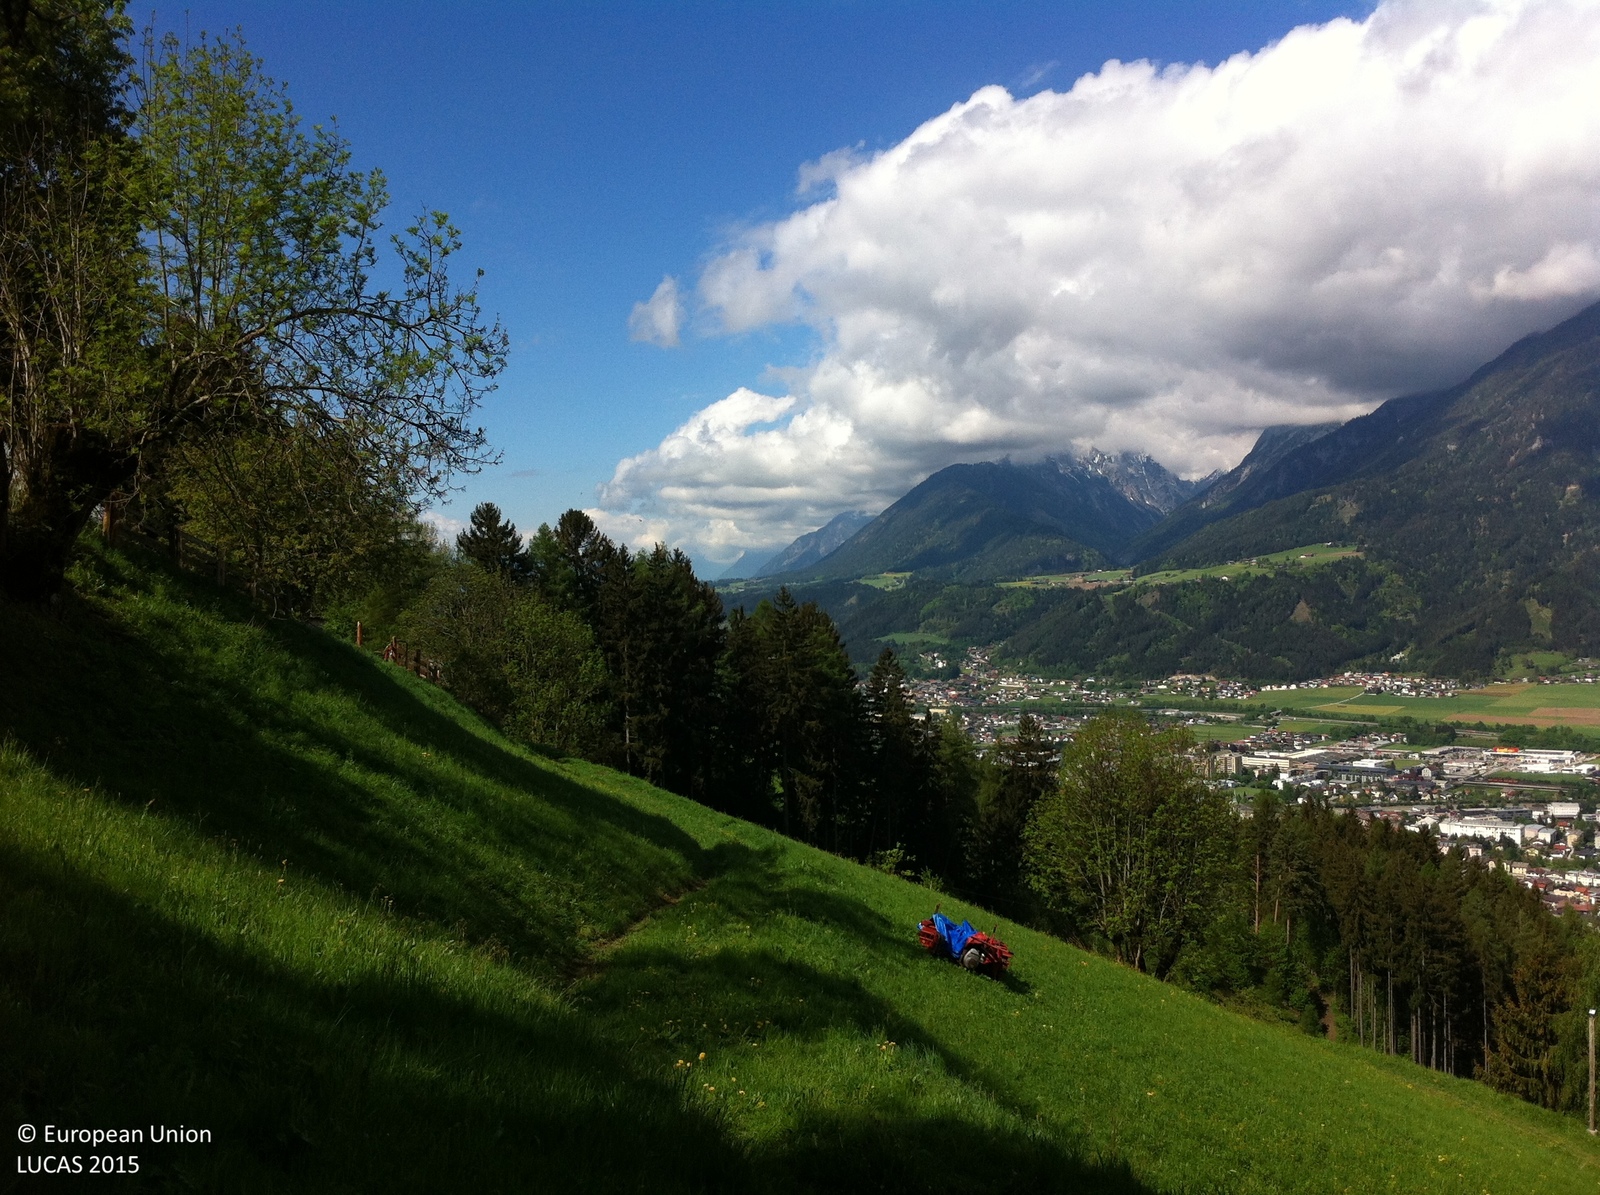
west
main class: Grassland
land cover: Grassland without tree/shrub cover
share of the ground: > 75 %
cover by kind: herbaceous plants 100 %
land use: Agriculture (excluding fallow land and kitchen gardens)
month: May
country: AT
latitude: 47.3458
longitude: 11.7325
